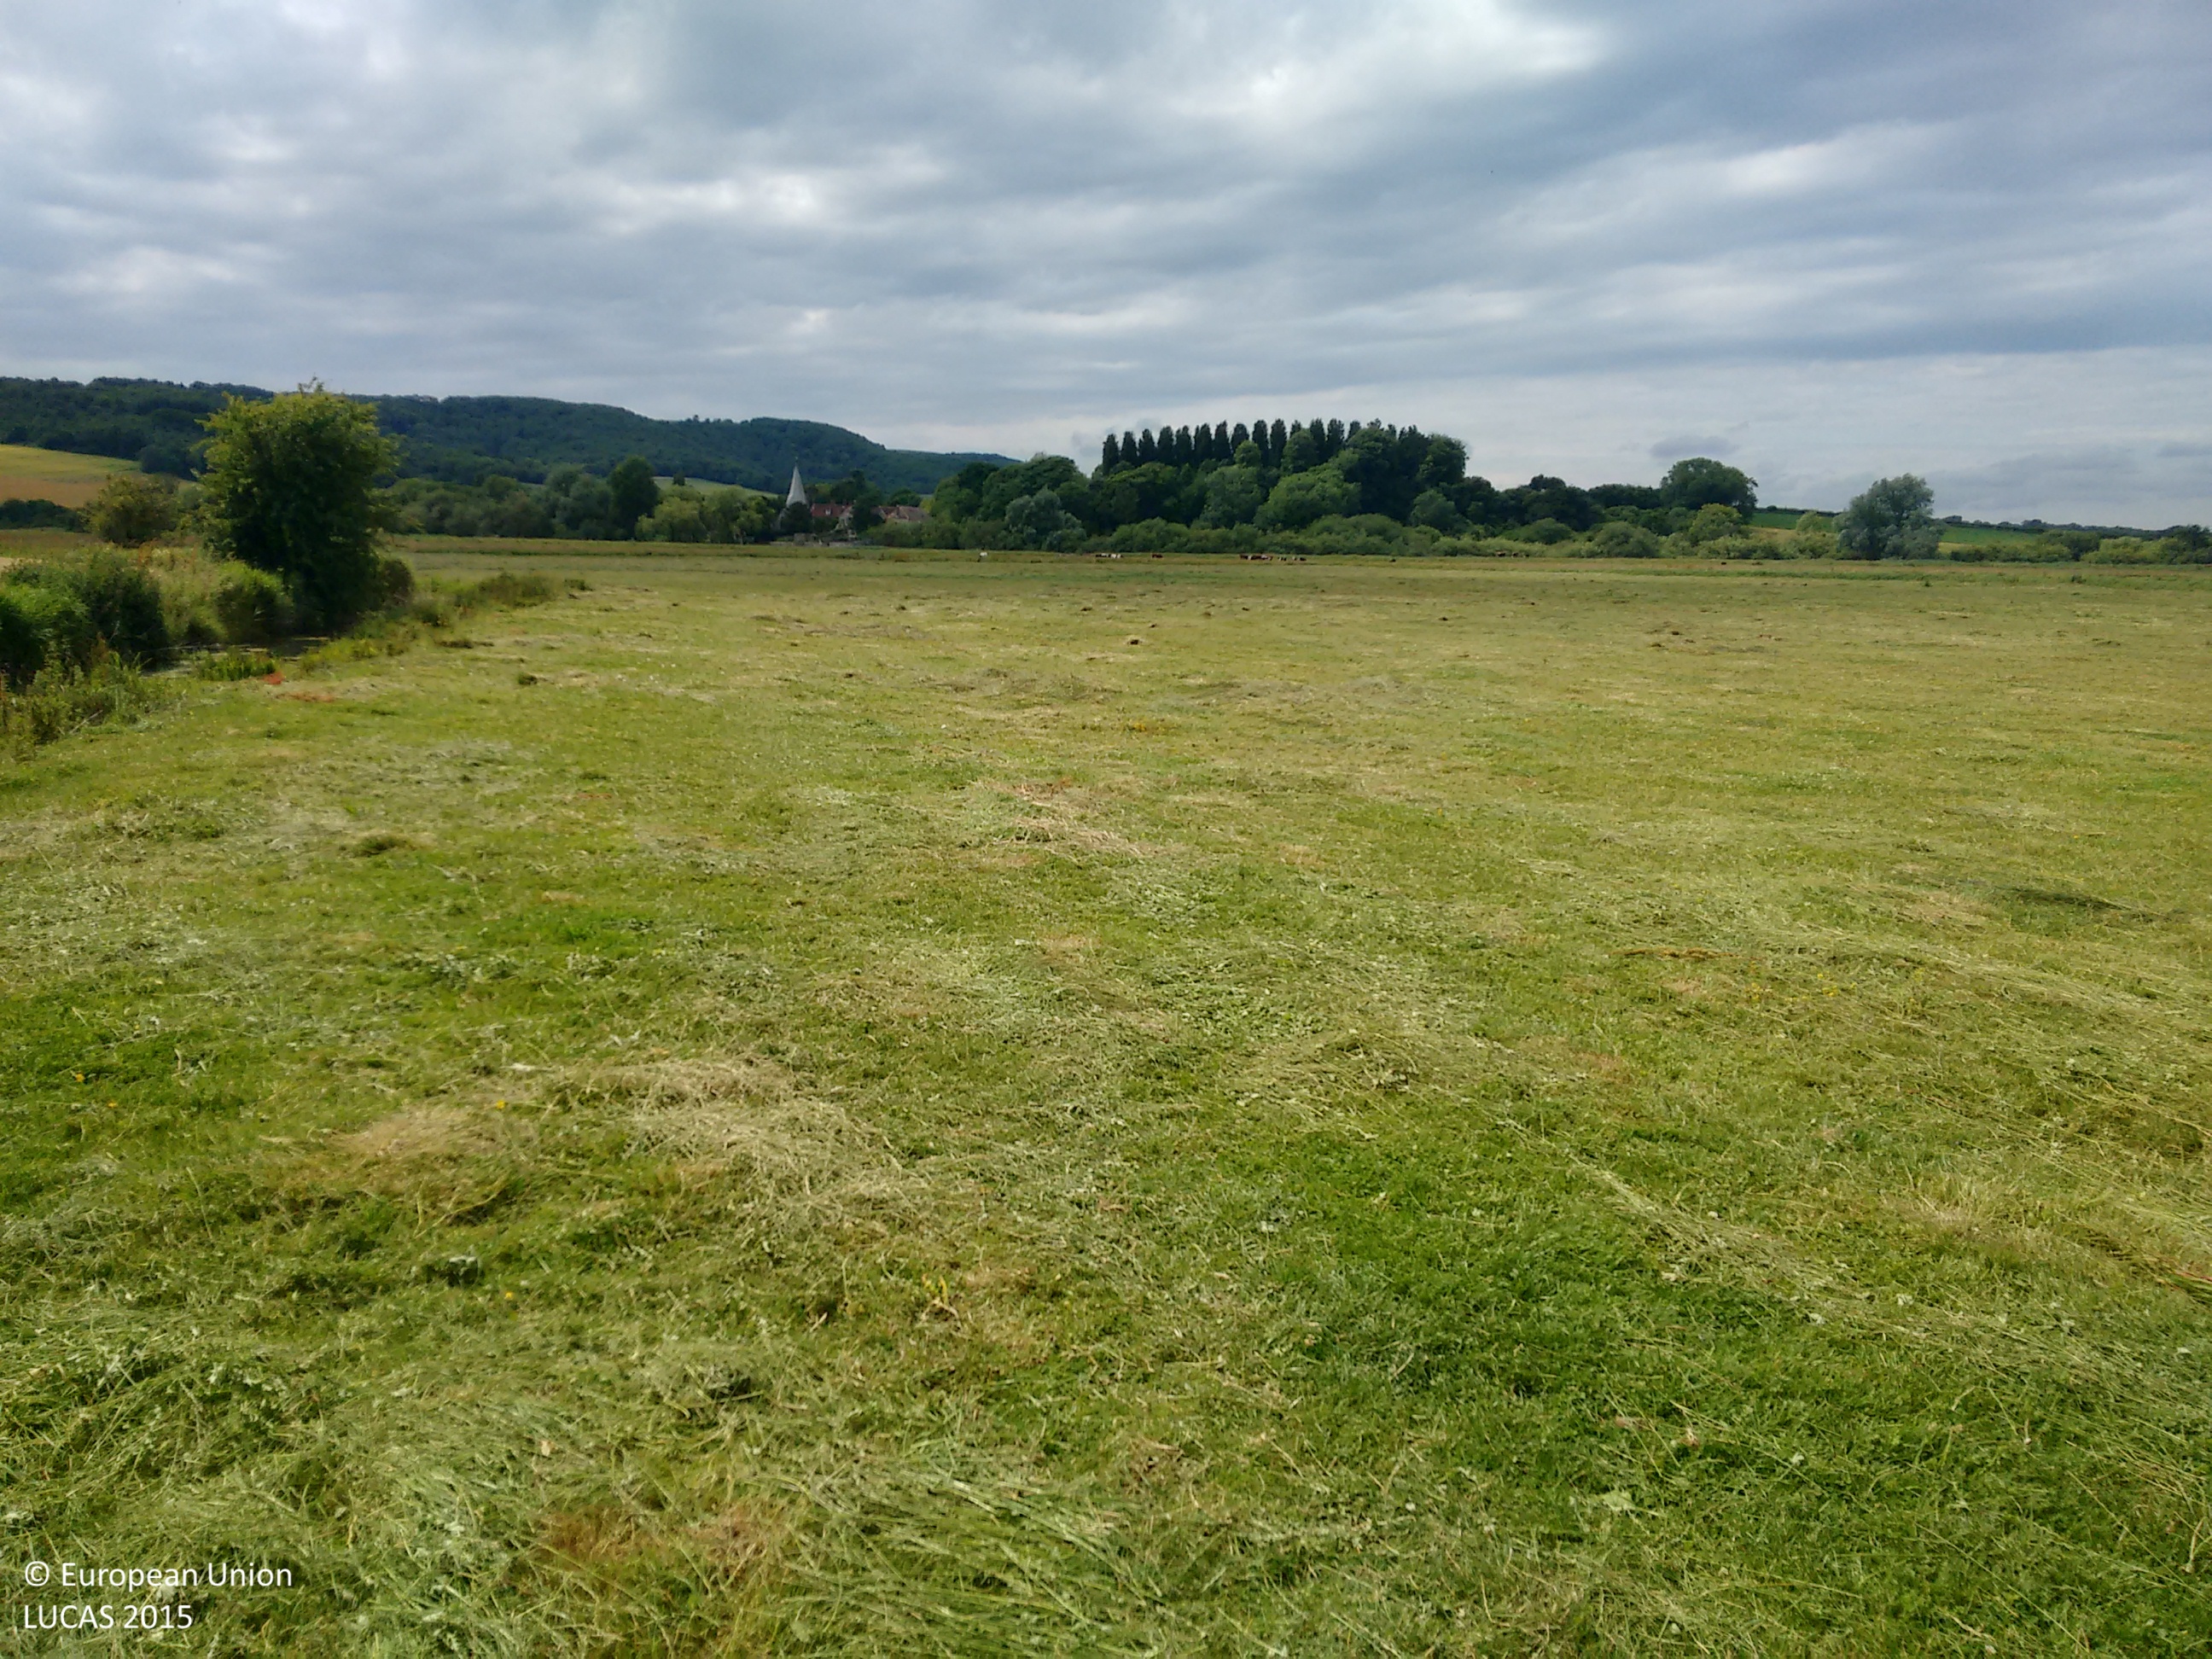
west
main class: Grassland
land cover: Grassland without tree/shrub cover
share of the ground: > 75 %
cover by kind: herbaceous plants 100 %
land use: Agriculture (excluding fallow land and kitchen gardens)
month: July
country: GB
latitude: 50.9086
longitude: -0.5487
